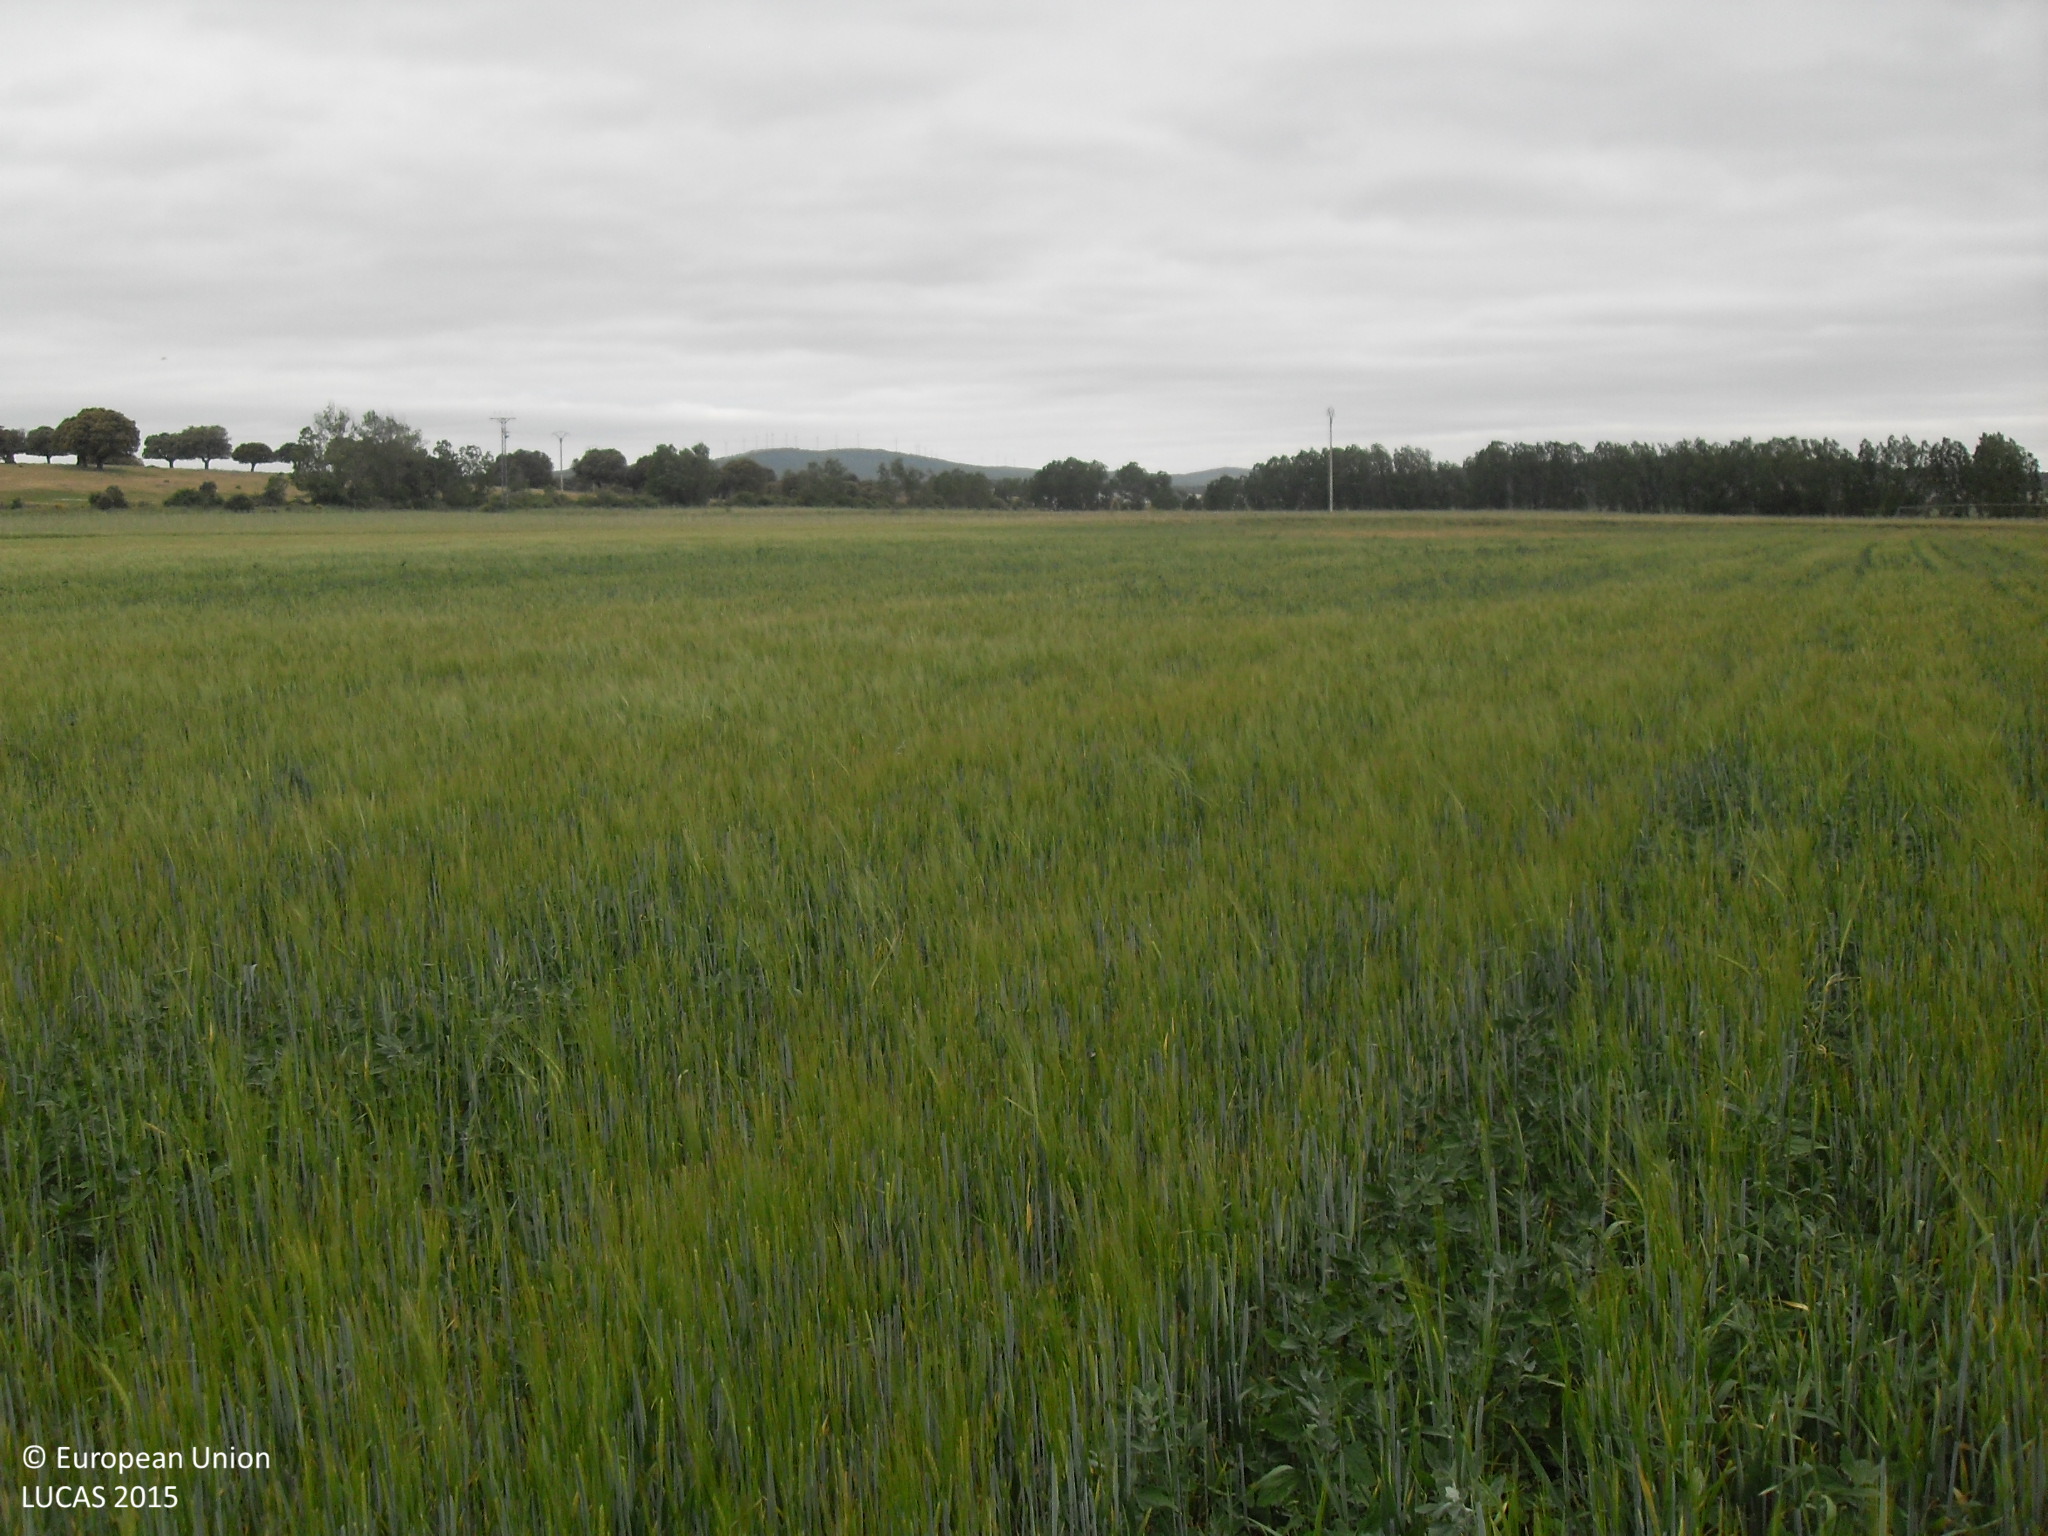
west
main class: Cropland
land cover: Barley
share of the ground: > 75 %
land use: Agriculture (excluding fallow land and kitchen gardens)
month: May
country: ES
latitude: 40.6750
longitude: -5.6537
